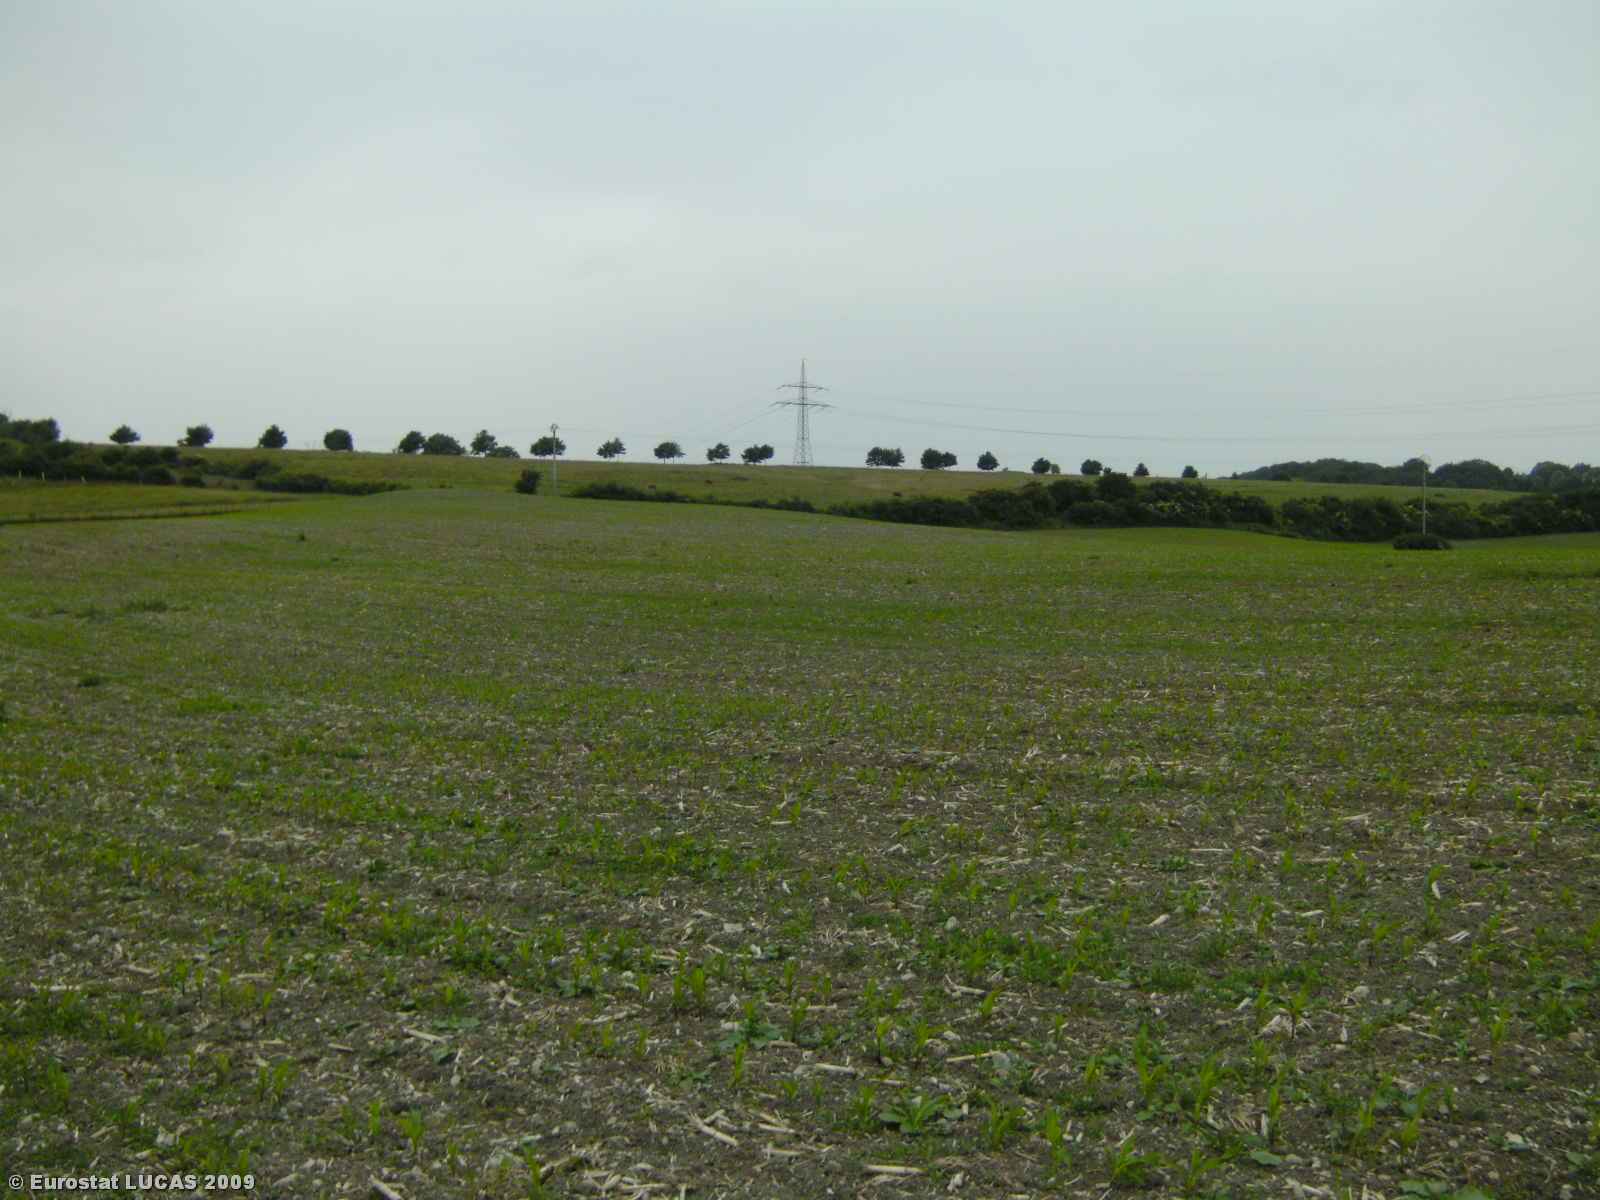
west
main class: Cropland
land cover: Maize
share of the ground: 10 - 25 %
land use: Agriculture (excluding fallow land and kitchen gardens)
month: June
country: LU
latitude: 49.7271
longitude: 6.2678
